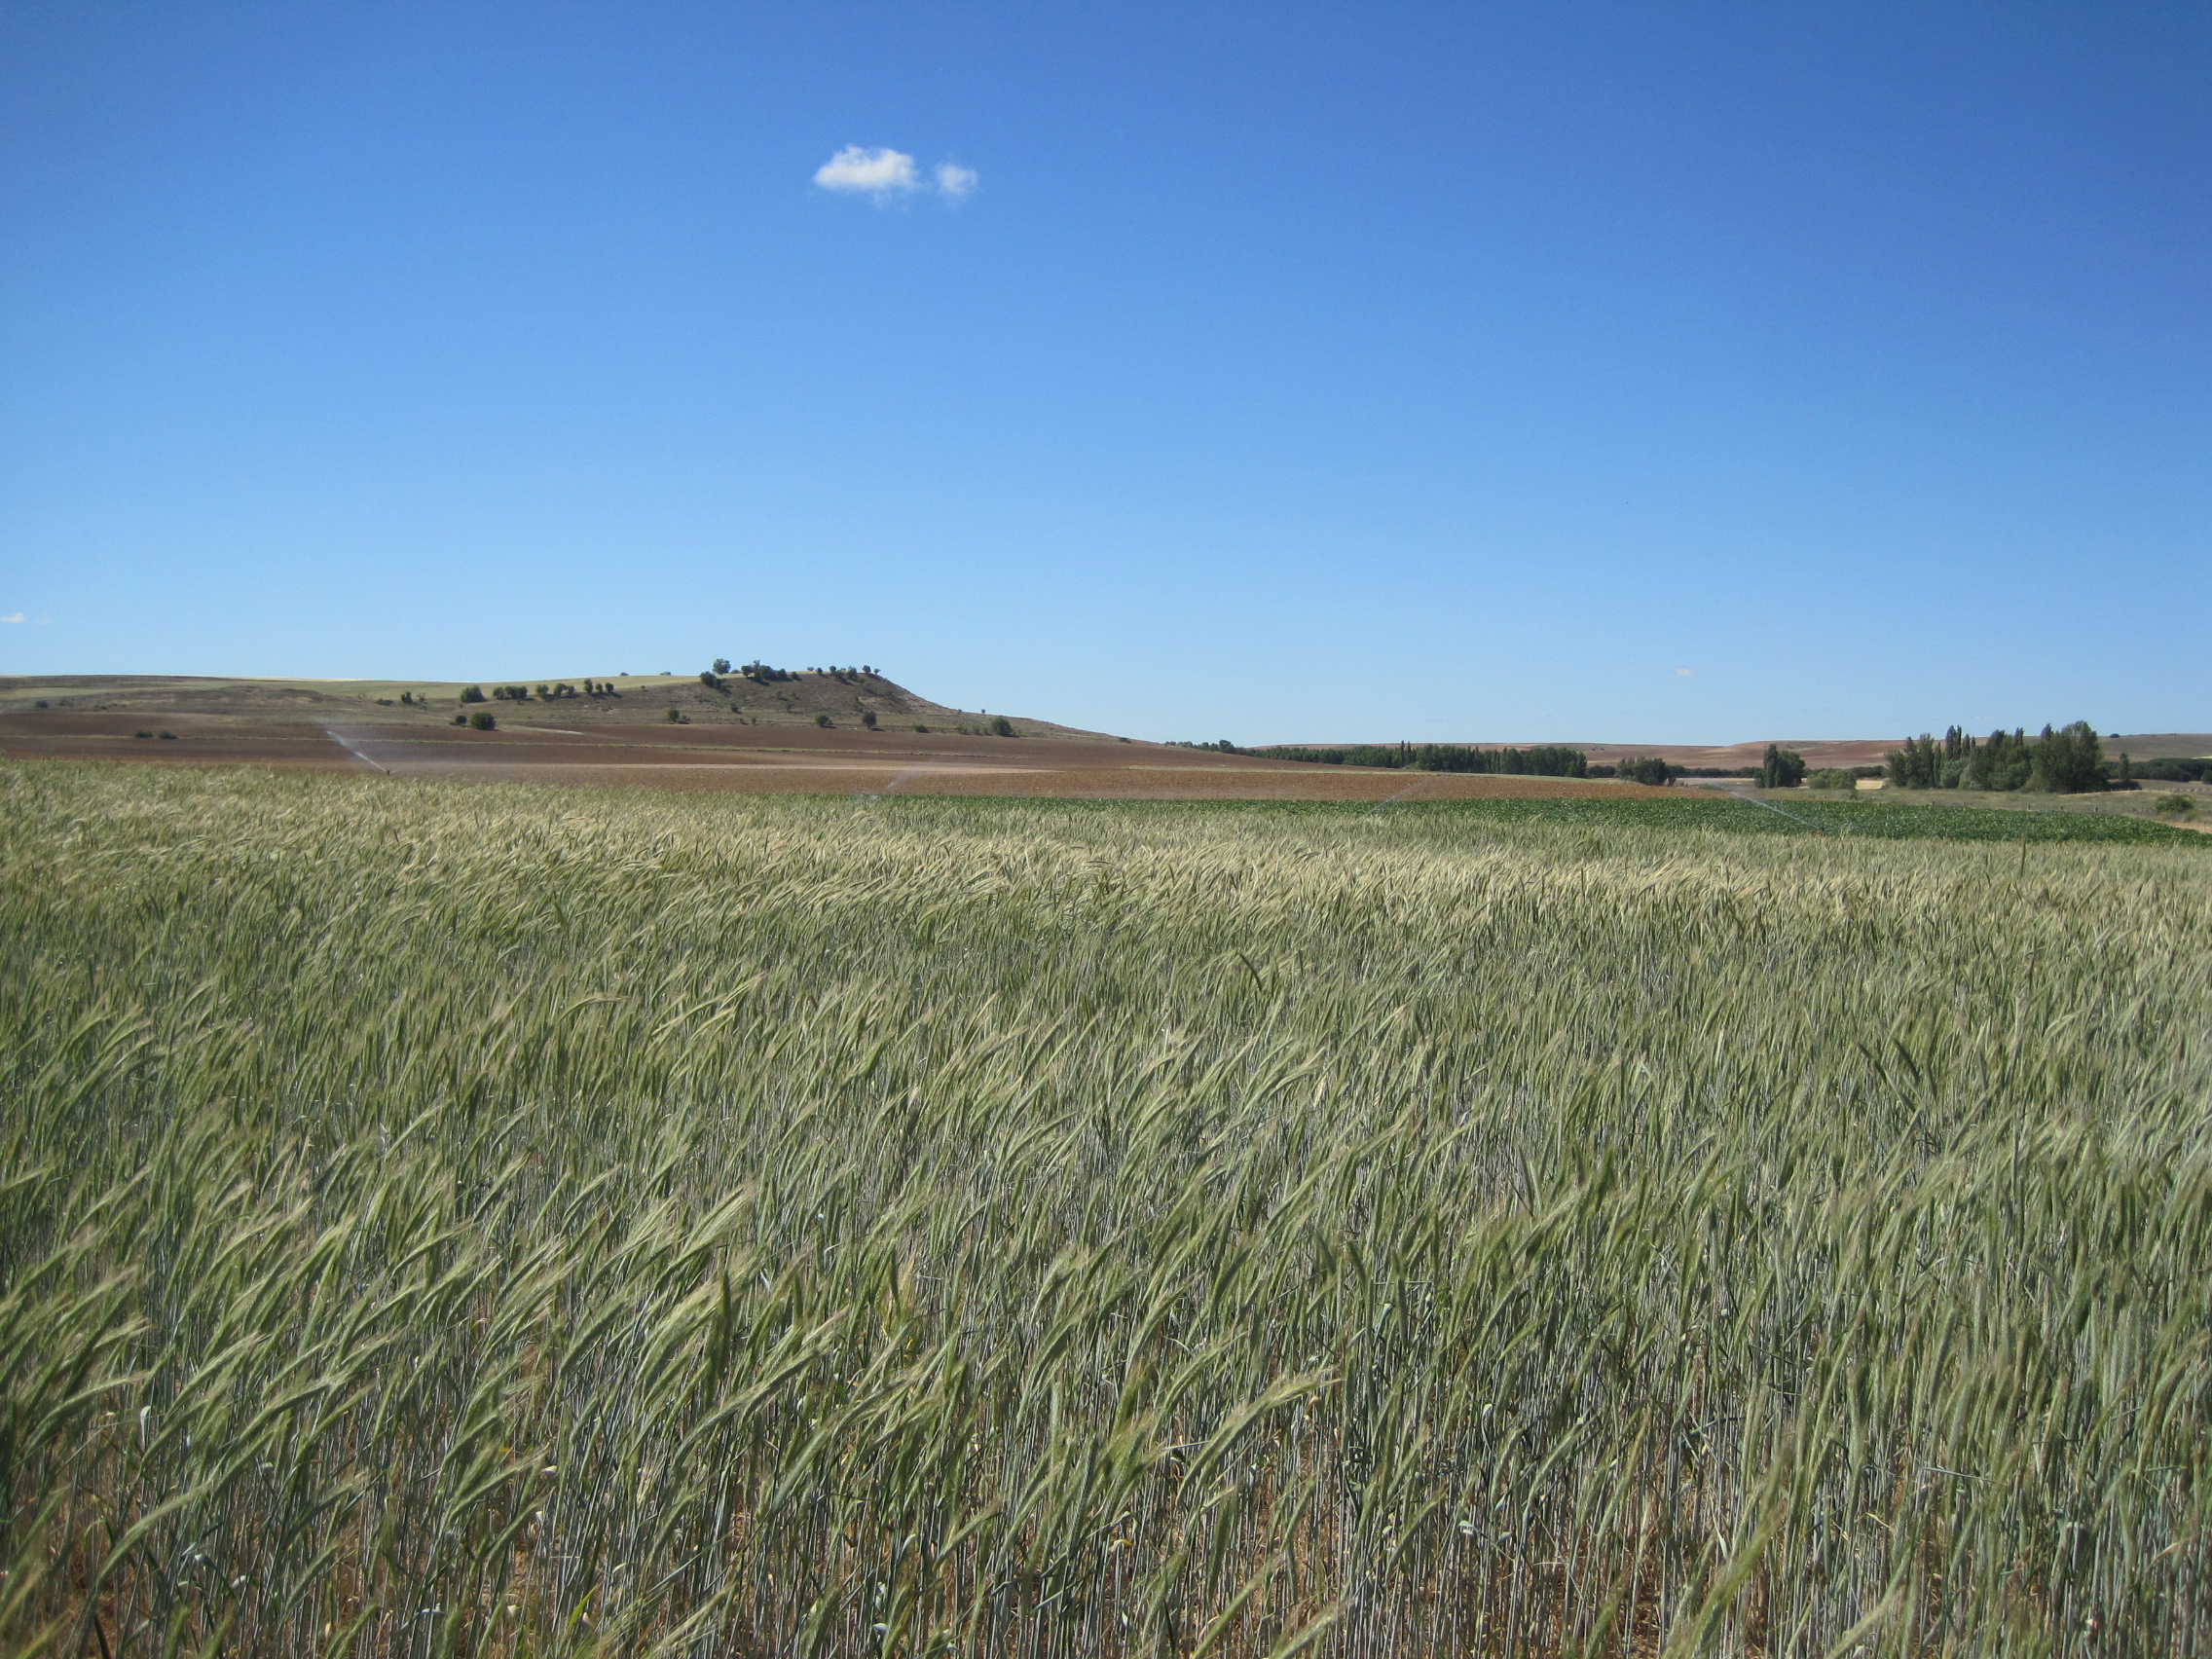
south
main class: Cropland
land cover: Rye
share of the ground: > 75 %
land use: Agriculture (excluding fallow land and kitchen gardens)
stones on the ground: < 10 %
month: May
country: ES
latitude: 41.1725
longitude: -5.2944
